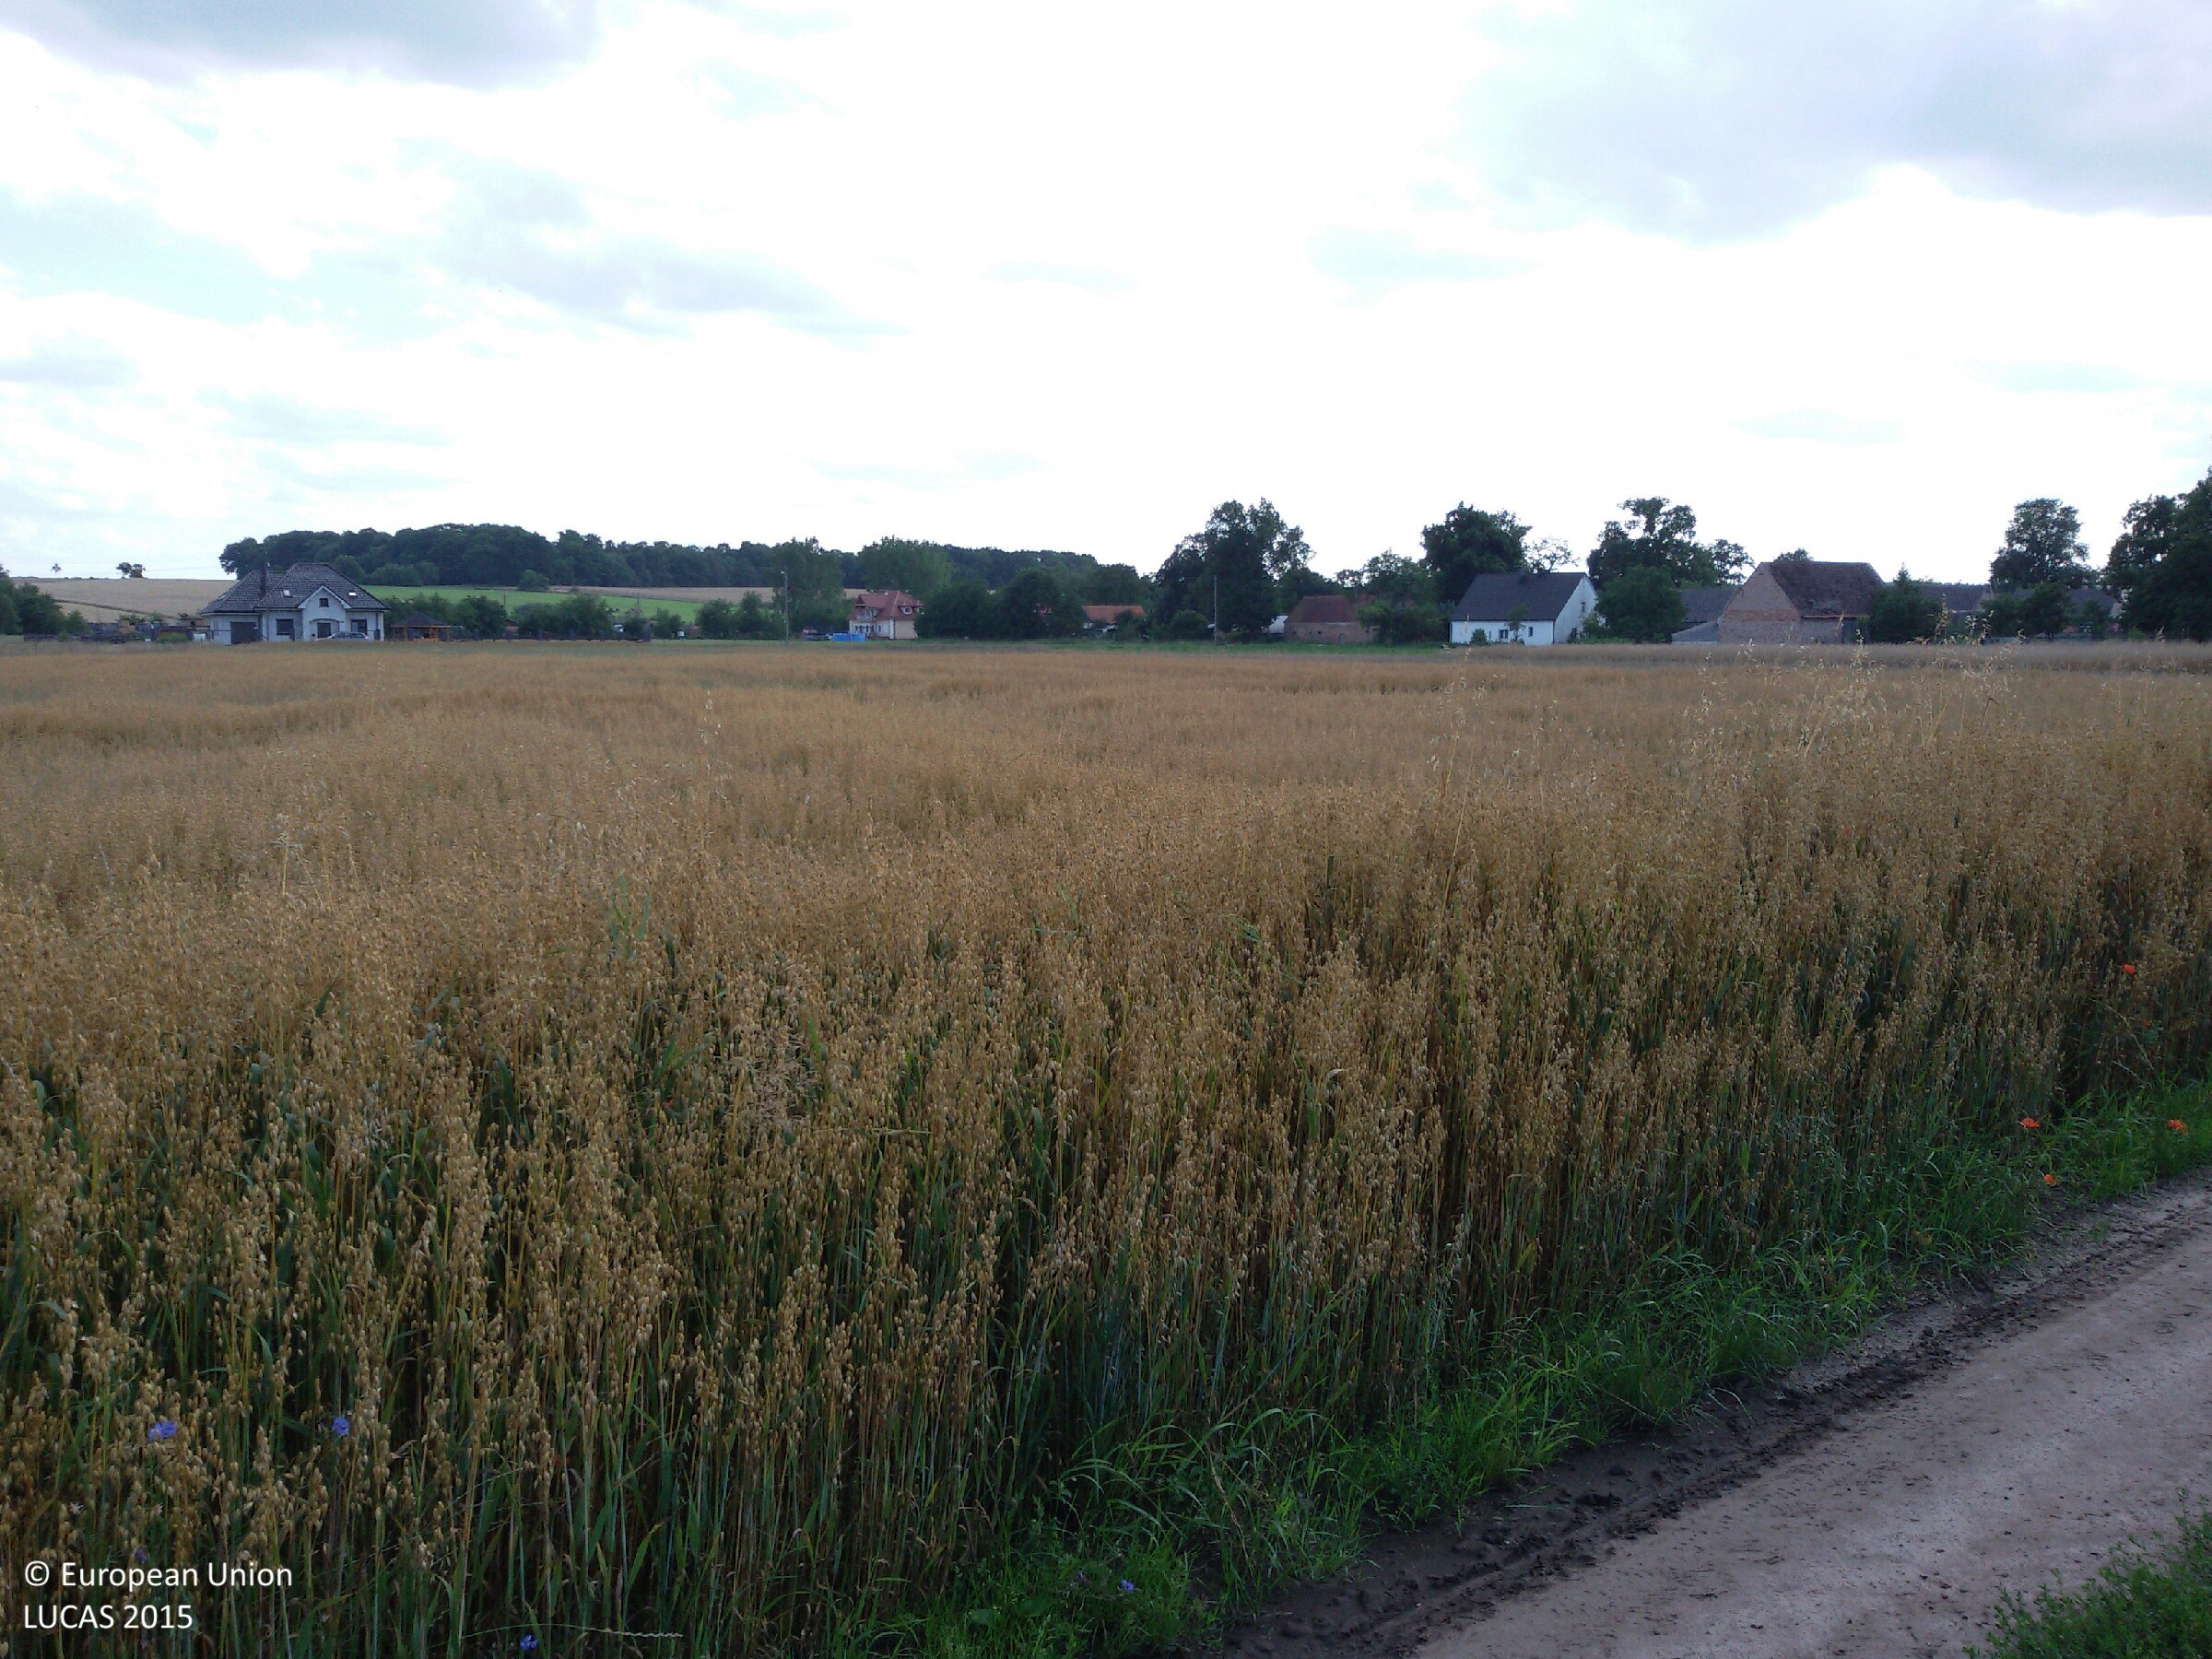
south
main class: Cropland
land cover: Rye
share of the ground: > 75 %
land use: Agriculture (excluding fallow land and kitchen gardens)
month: July
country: PL
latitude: 52.5340
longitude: 14.7638
